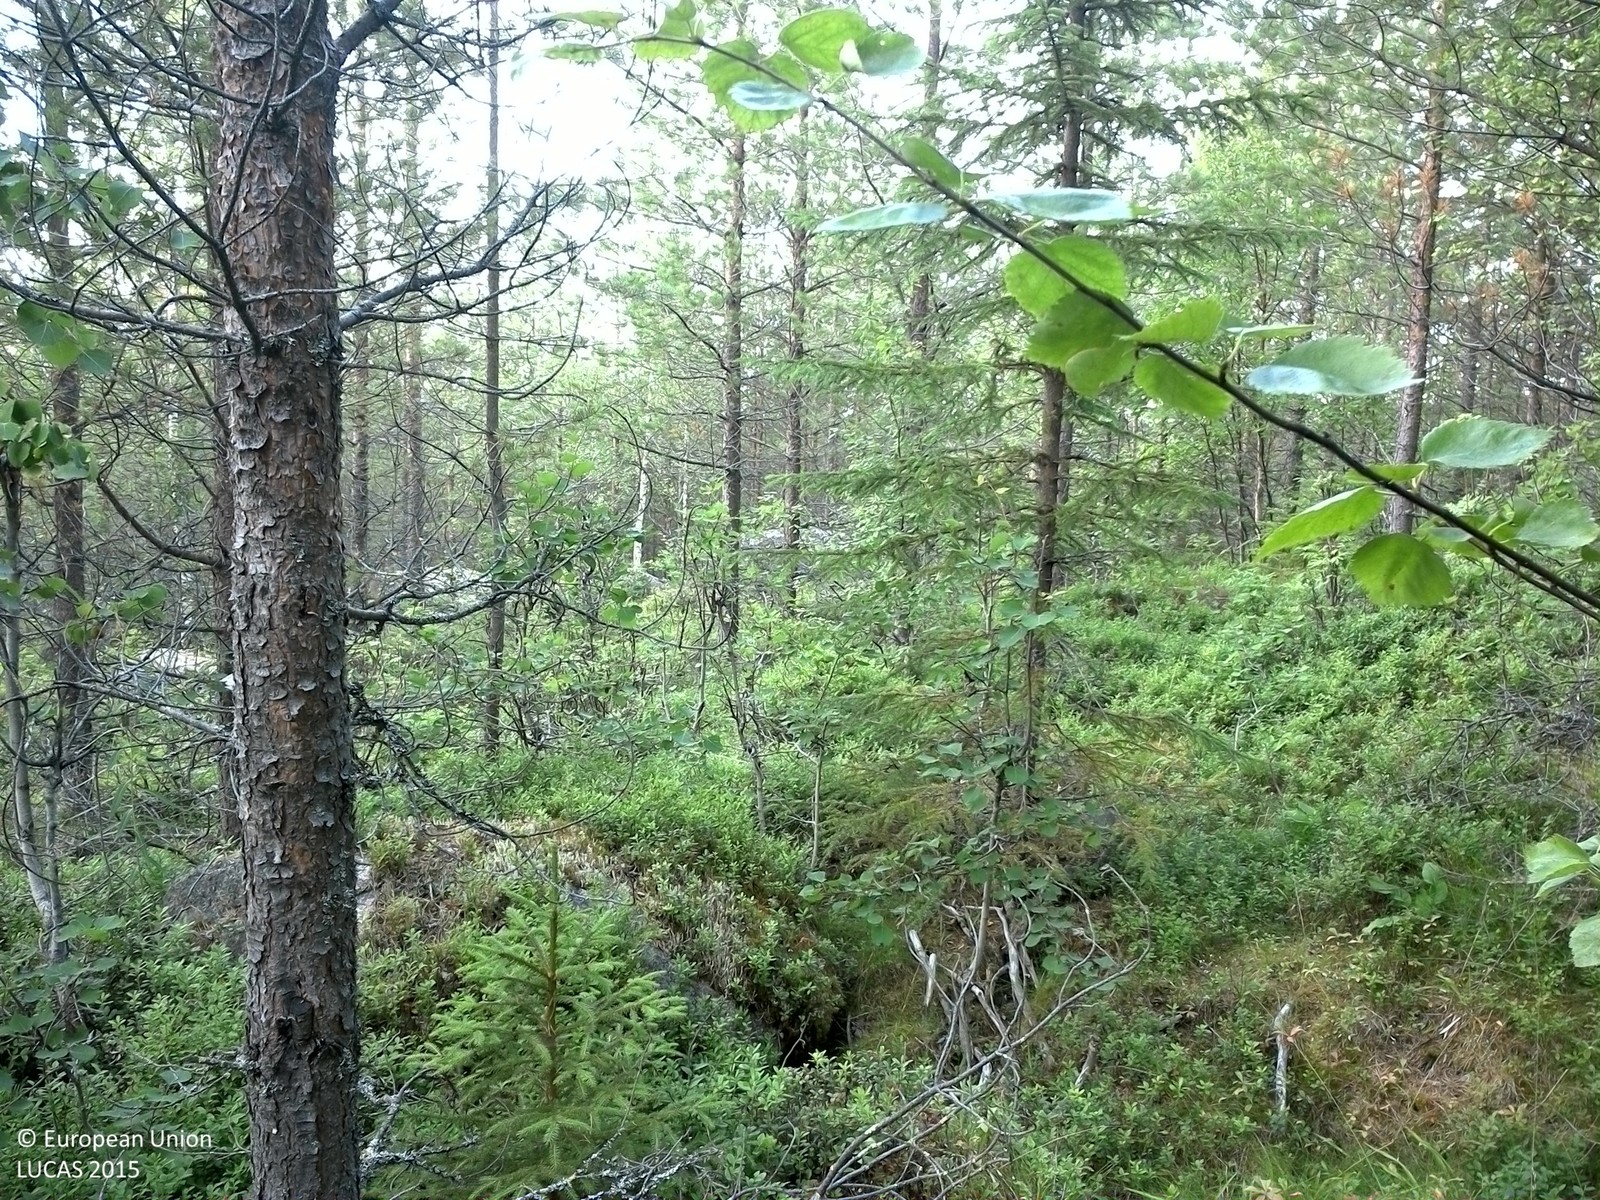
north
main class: Woodland
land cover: Pine dominated mixed woodland
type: boreal forest
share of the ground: 50 - 75 %
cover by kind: coniferous forest trees 45 %, shrubs 25 %, broadleaved forest trees 15 %, lichens and mosses 10 %, herbaceous plants 5 %
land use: Forestry
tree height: > 5 m
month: August
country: SE
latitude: 63.7405
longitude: 16.4753
